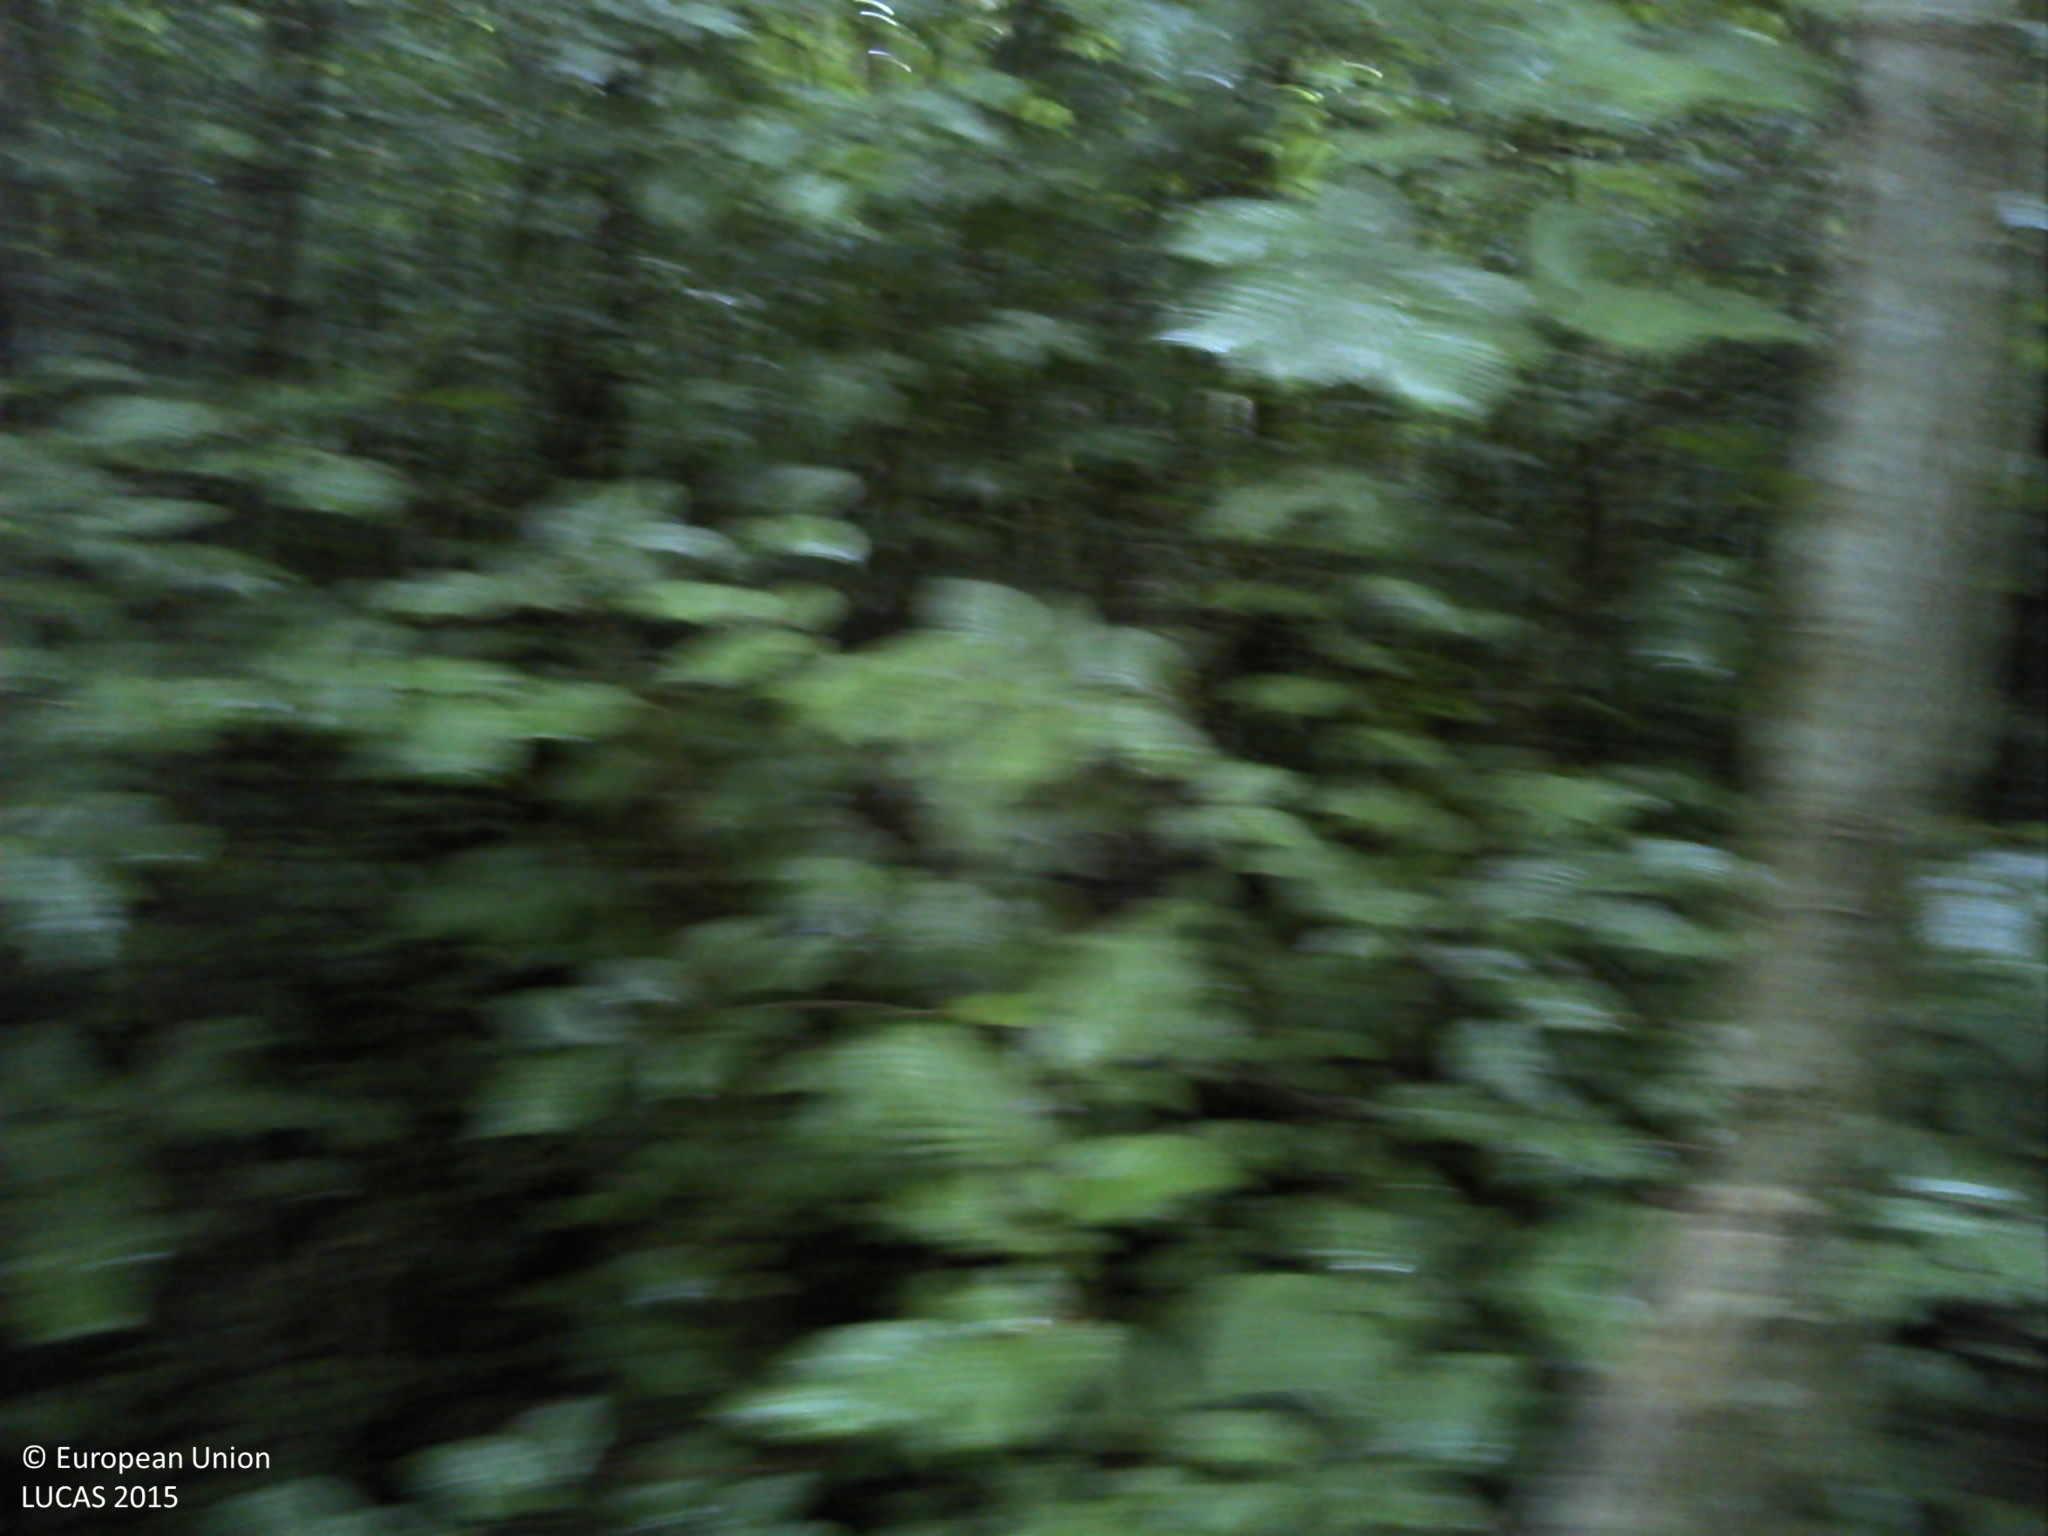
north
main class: Woodland
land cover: Broadleaved woodland
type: beech forest
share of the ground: > 75 %
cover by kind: broadleaved forest trees 85 %, herbaceous plants 5 %, lichens and mosses 5 %, consolidated bare surface 5 %
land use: Forestry
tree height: > 5 m
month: June
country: FR
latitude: 49.5345
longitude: 5.0093
